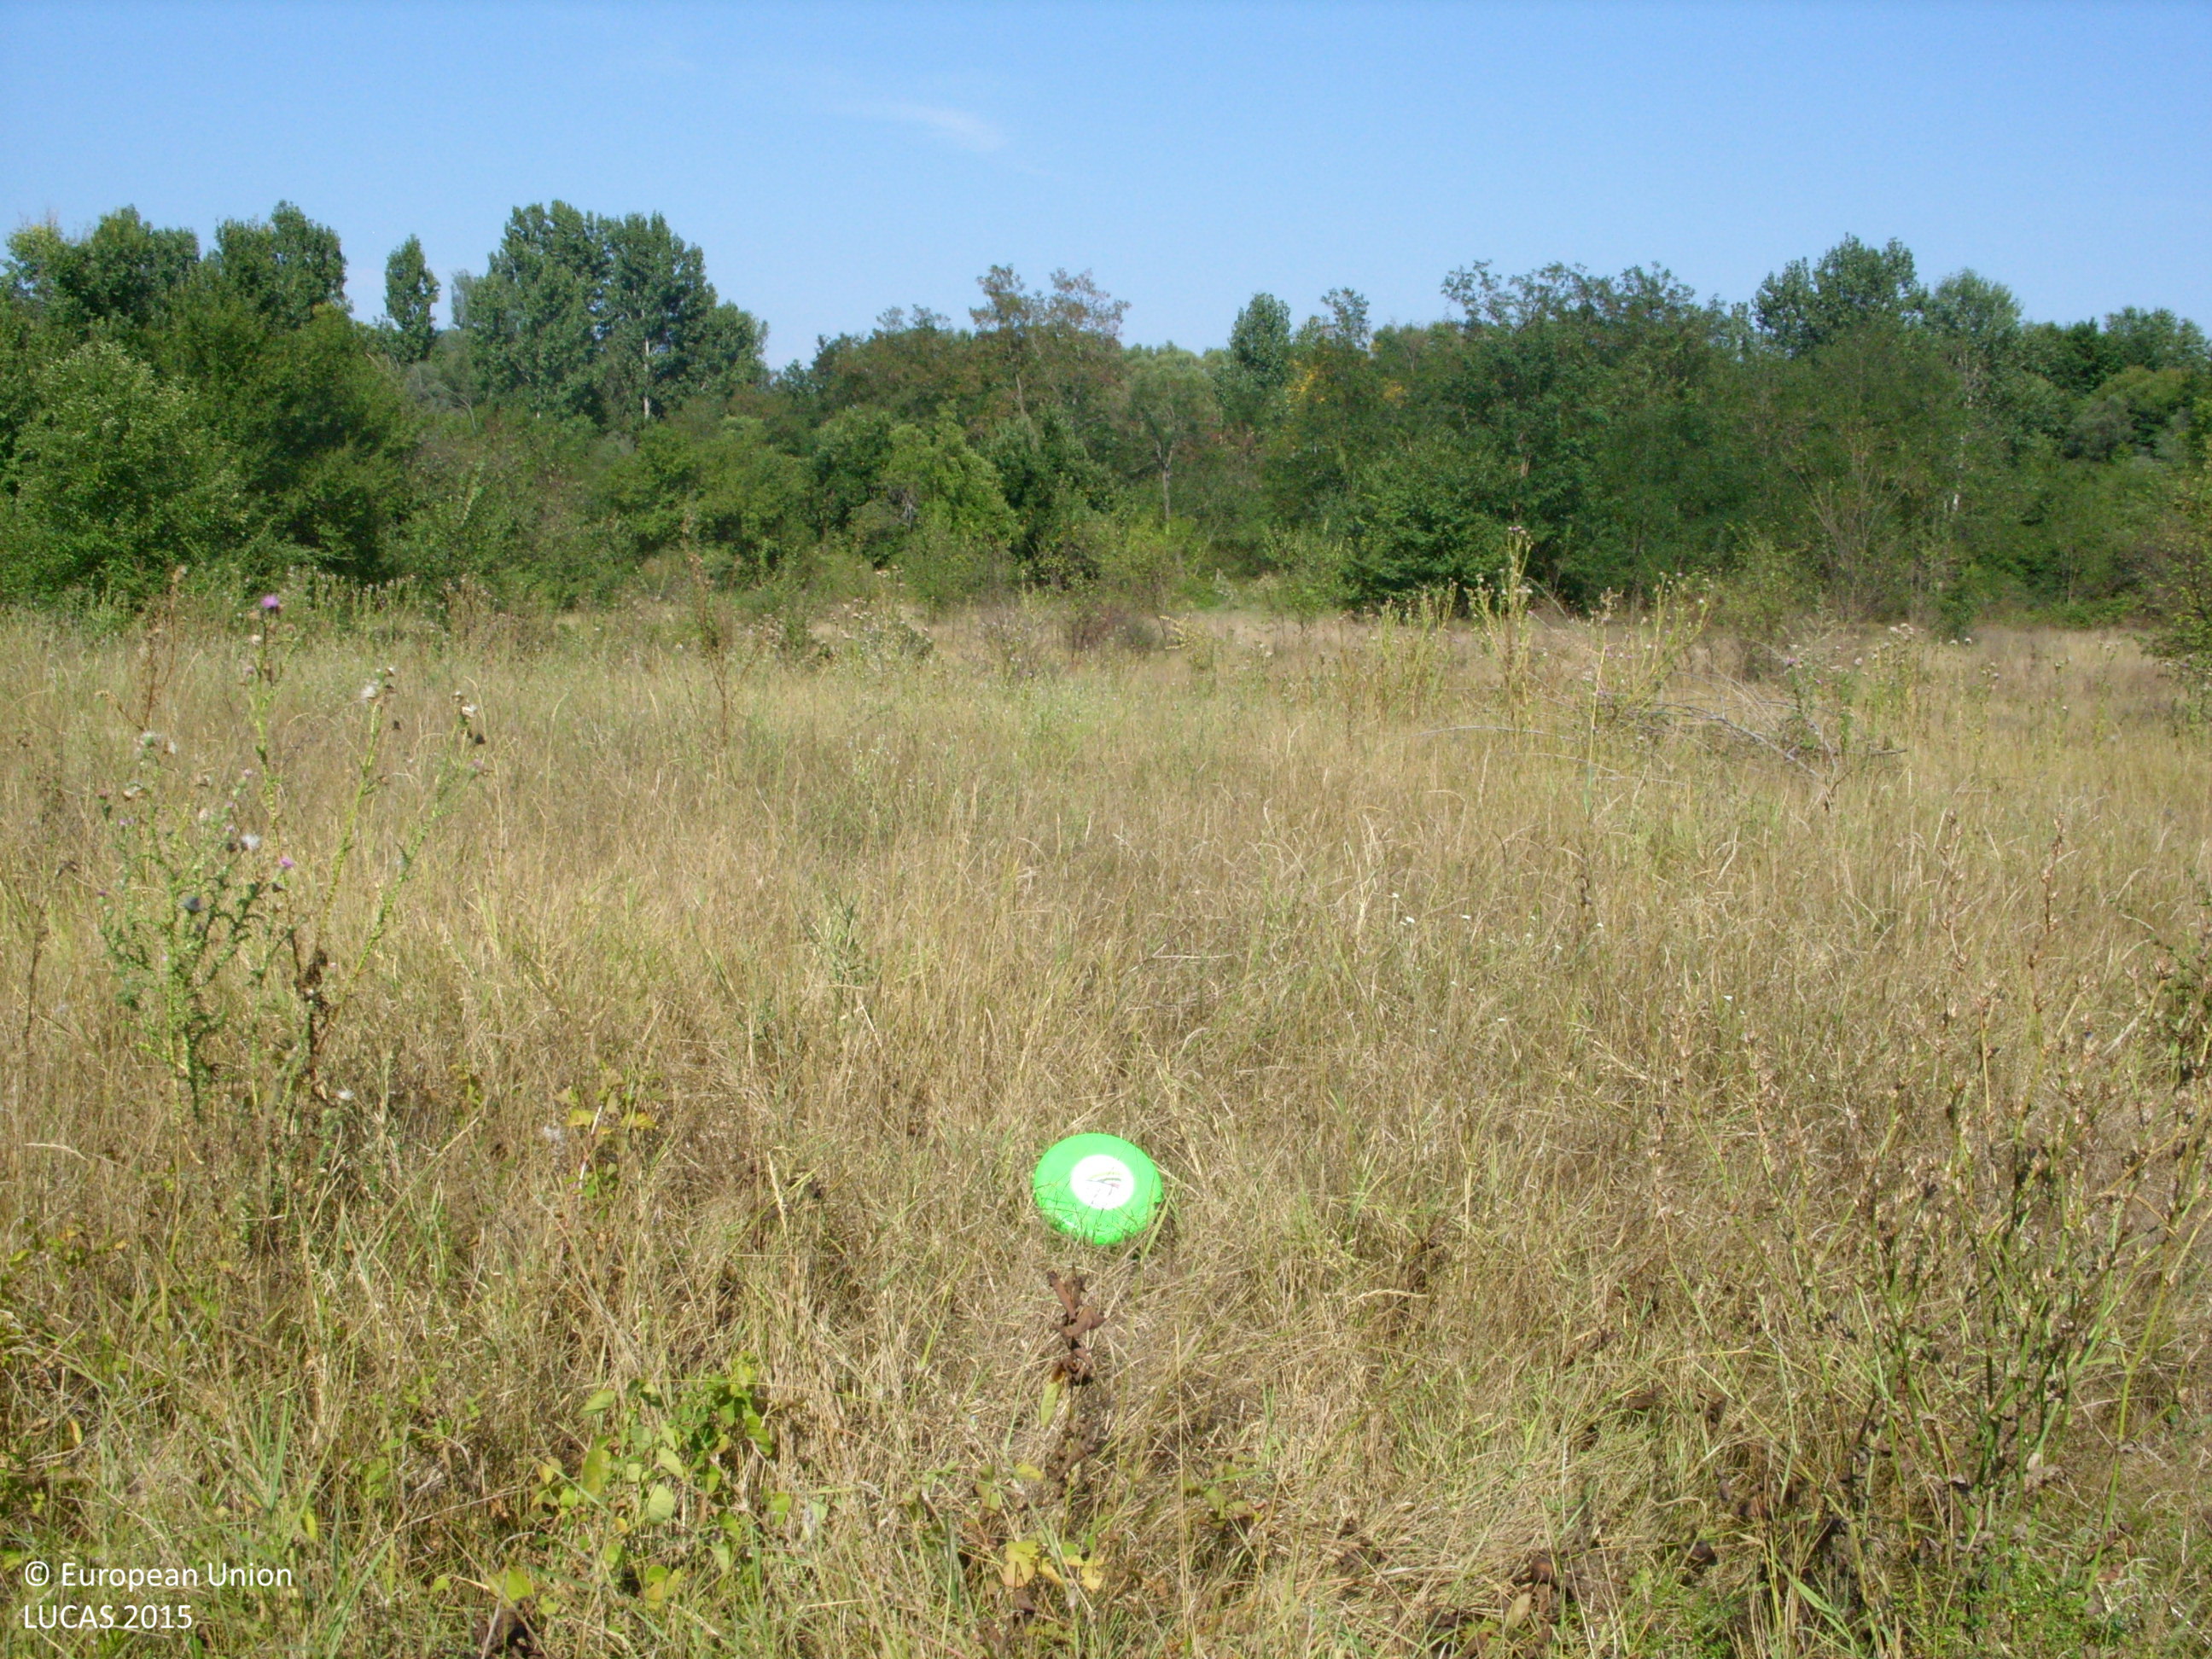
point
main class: Grassland
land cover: Grassland with sparse tree/shrub cover
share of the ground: > 75 %
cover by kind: herbaceous plants 90 %, broadleaved forest trees 5 %, shrubs 5 %
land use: Water supply and treatment
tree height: < 5 m
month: August
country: BG
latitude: 42.3788
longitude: 25.0839
